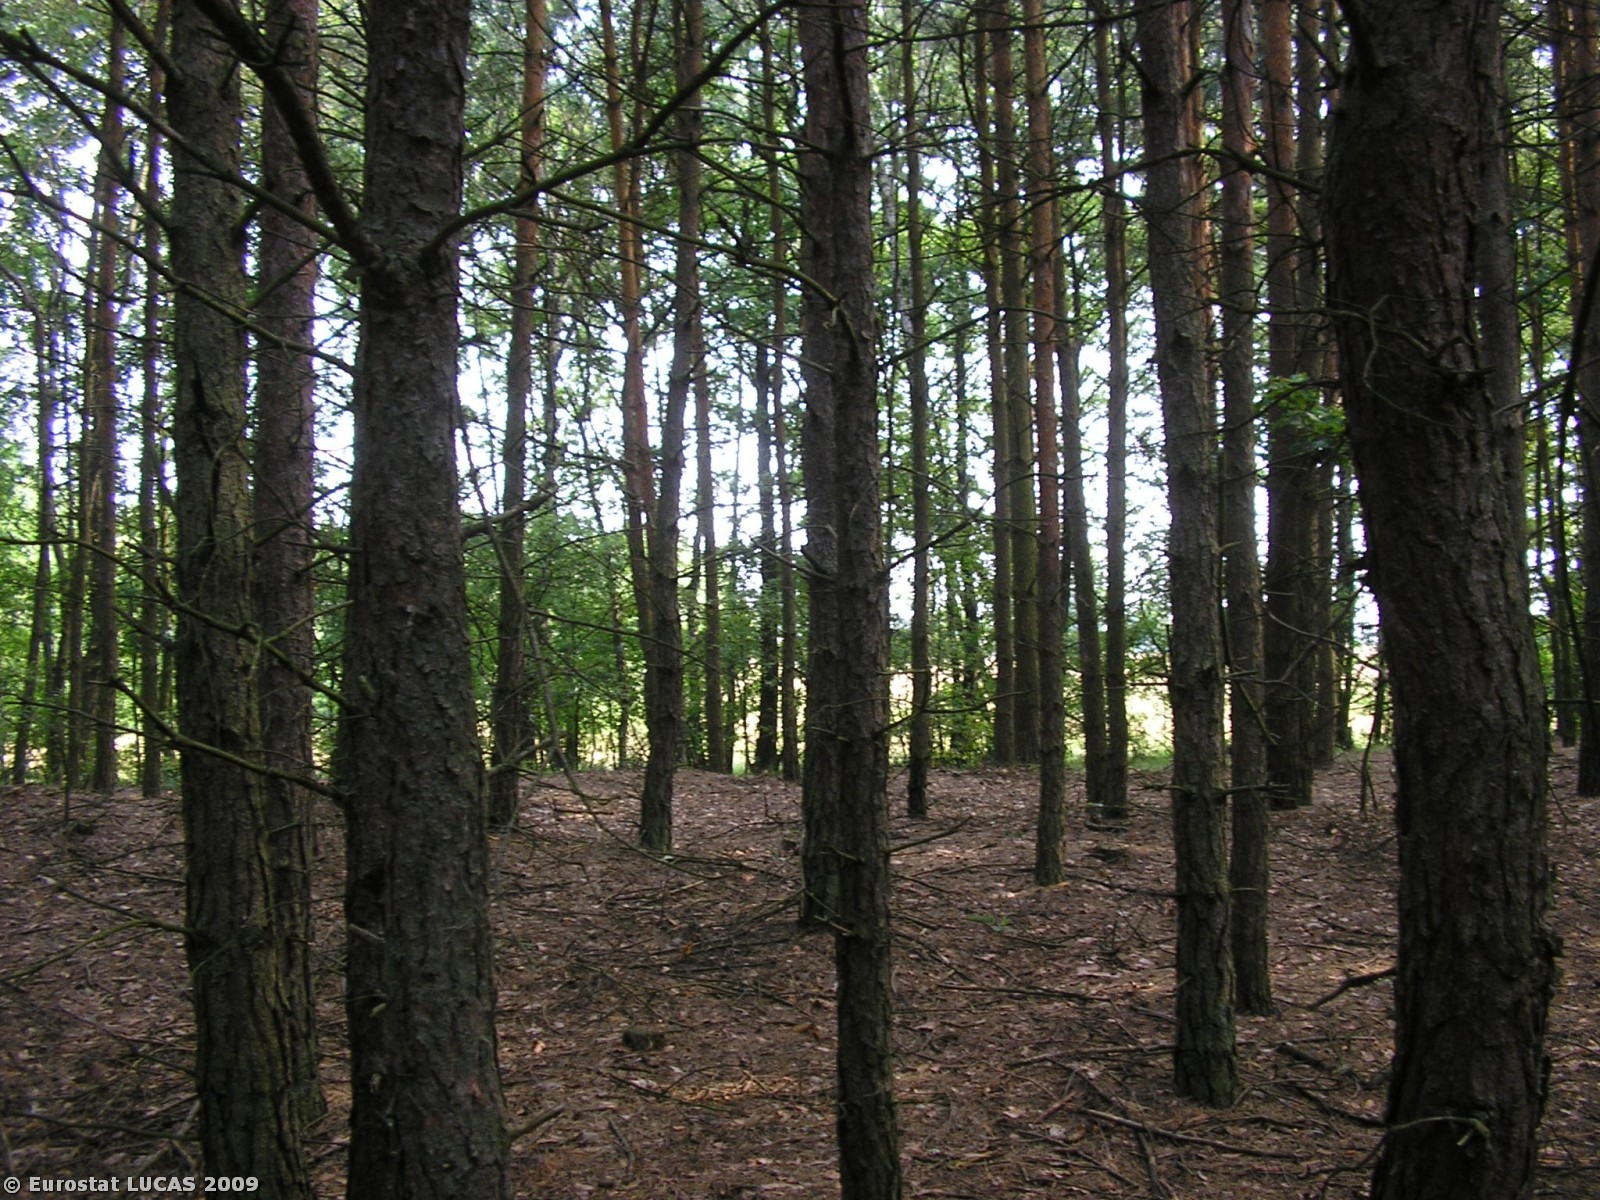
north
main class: Woodland
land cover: Coniferous woodland
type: hemiboreal forest and nemoral coniferous forest and mixed broadleaved-coniferous forest
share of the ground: > 75 %
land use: Forestry
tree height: > 5 m
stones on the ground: < 10 %
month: July
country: PL
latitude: 52.2596
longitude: 21.6122
